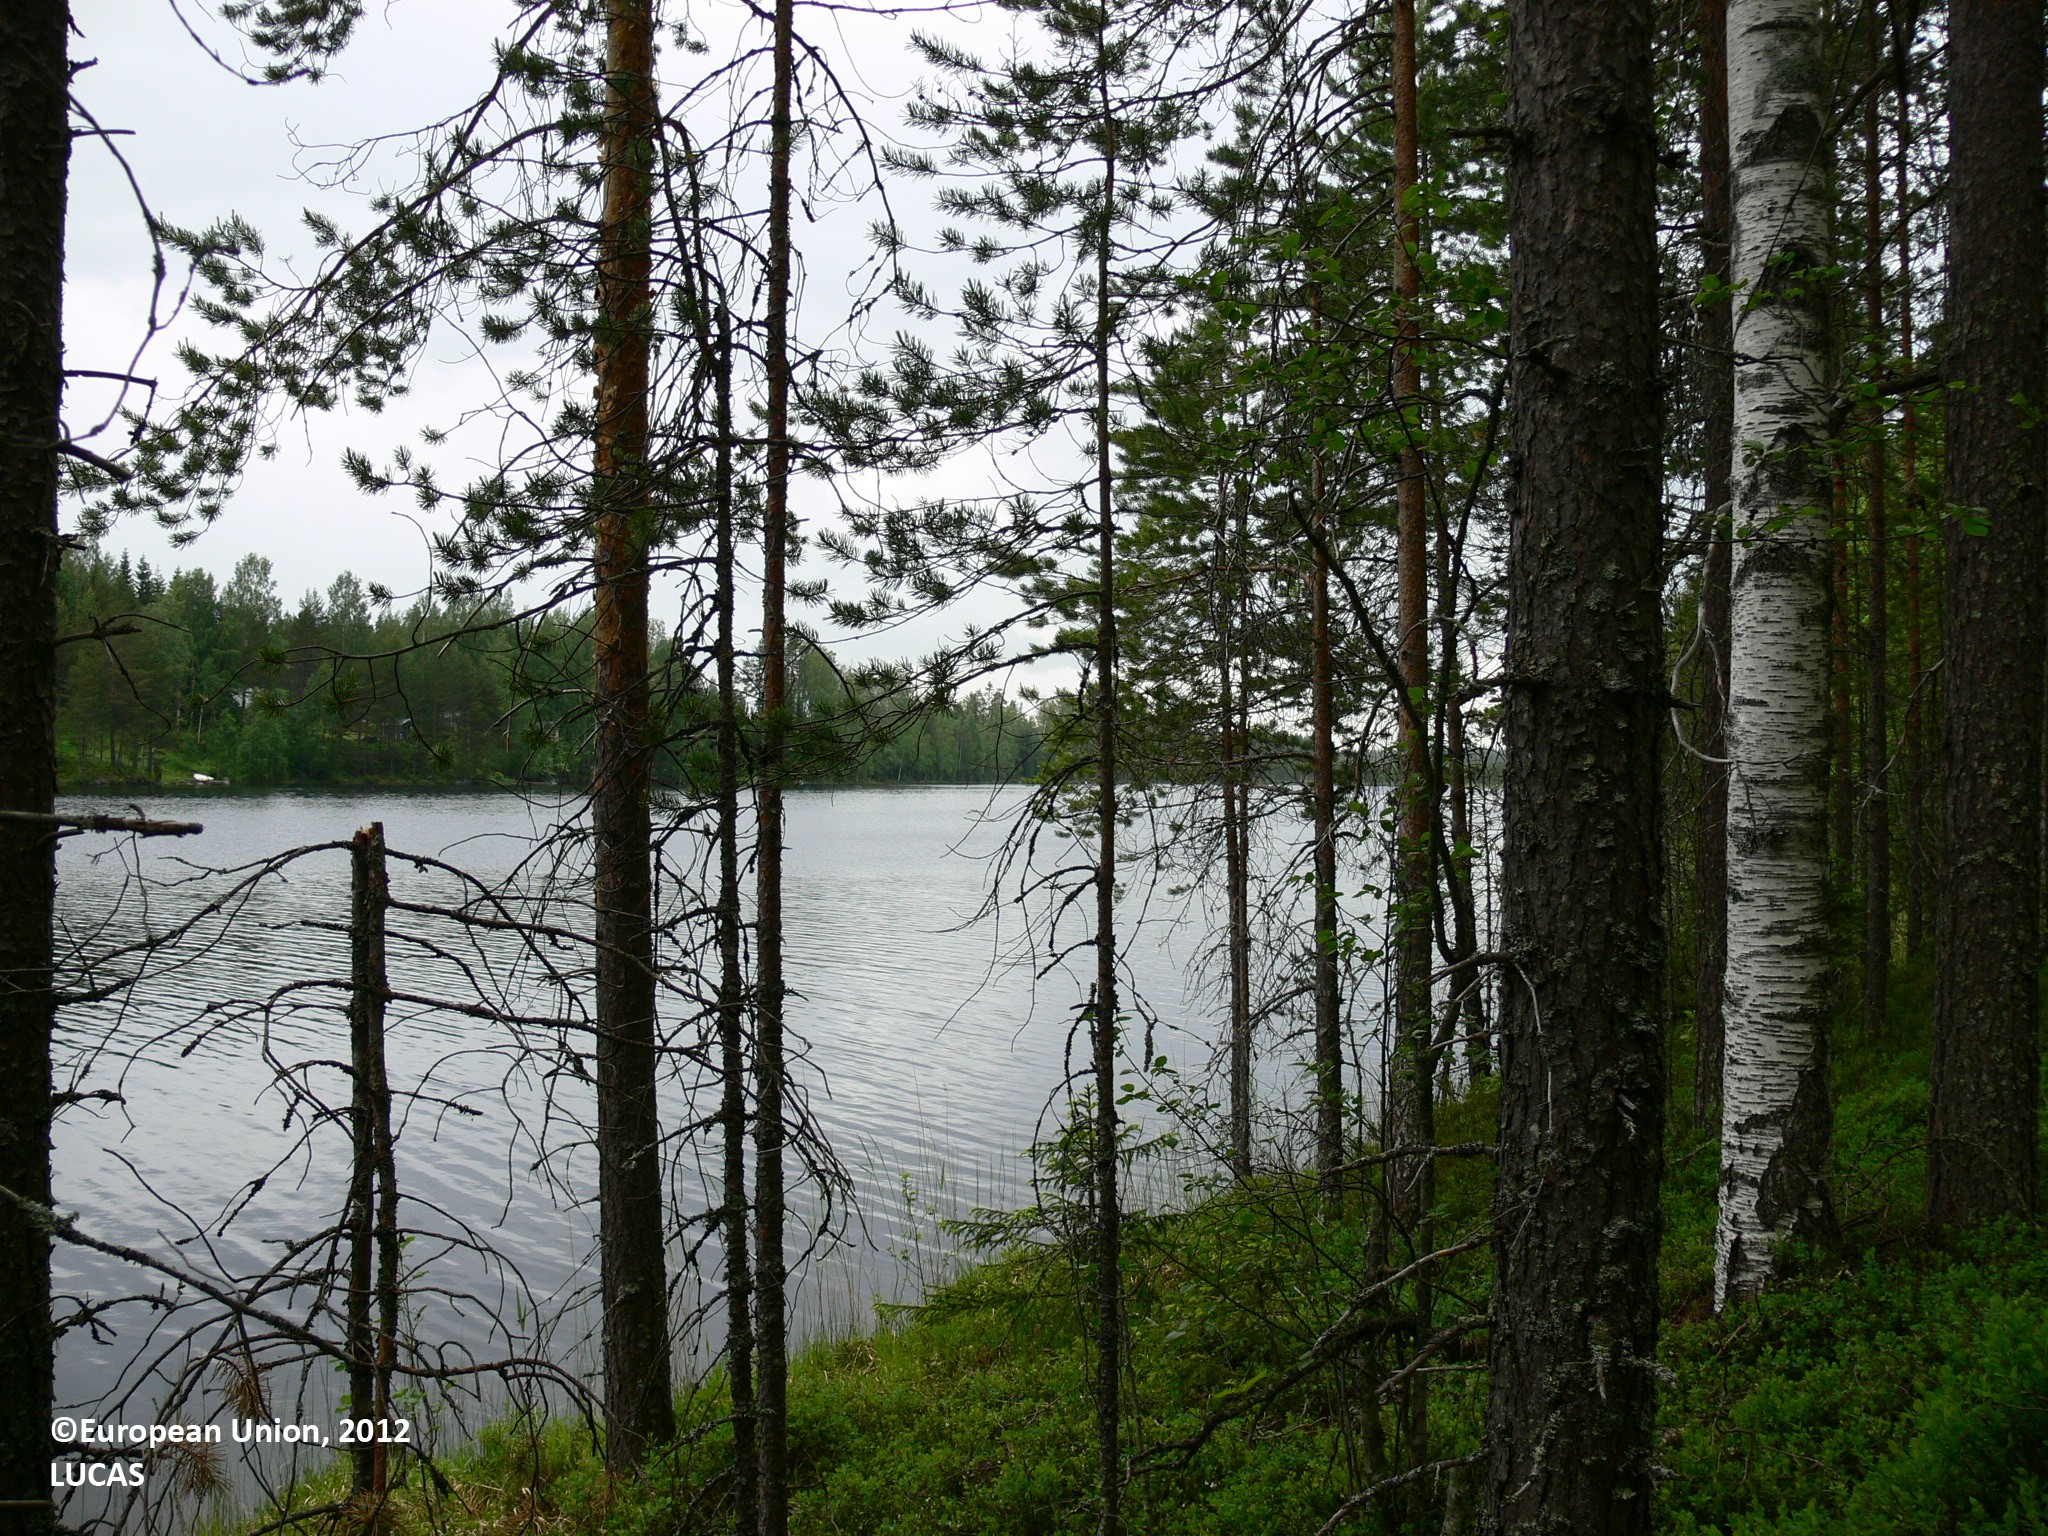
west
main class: Woodland
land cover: Pine dominated coniferous woodland
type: boreal forest
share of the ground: > 75 %
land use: Forestry
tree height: > 5 m
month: June
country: FI
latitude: 62.9290
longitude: 29.8872
